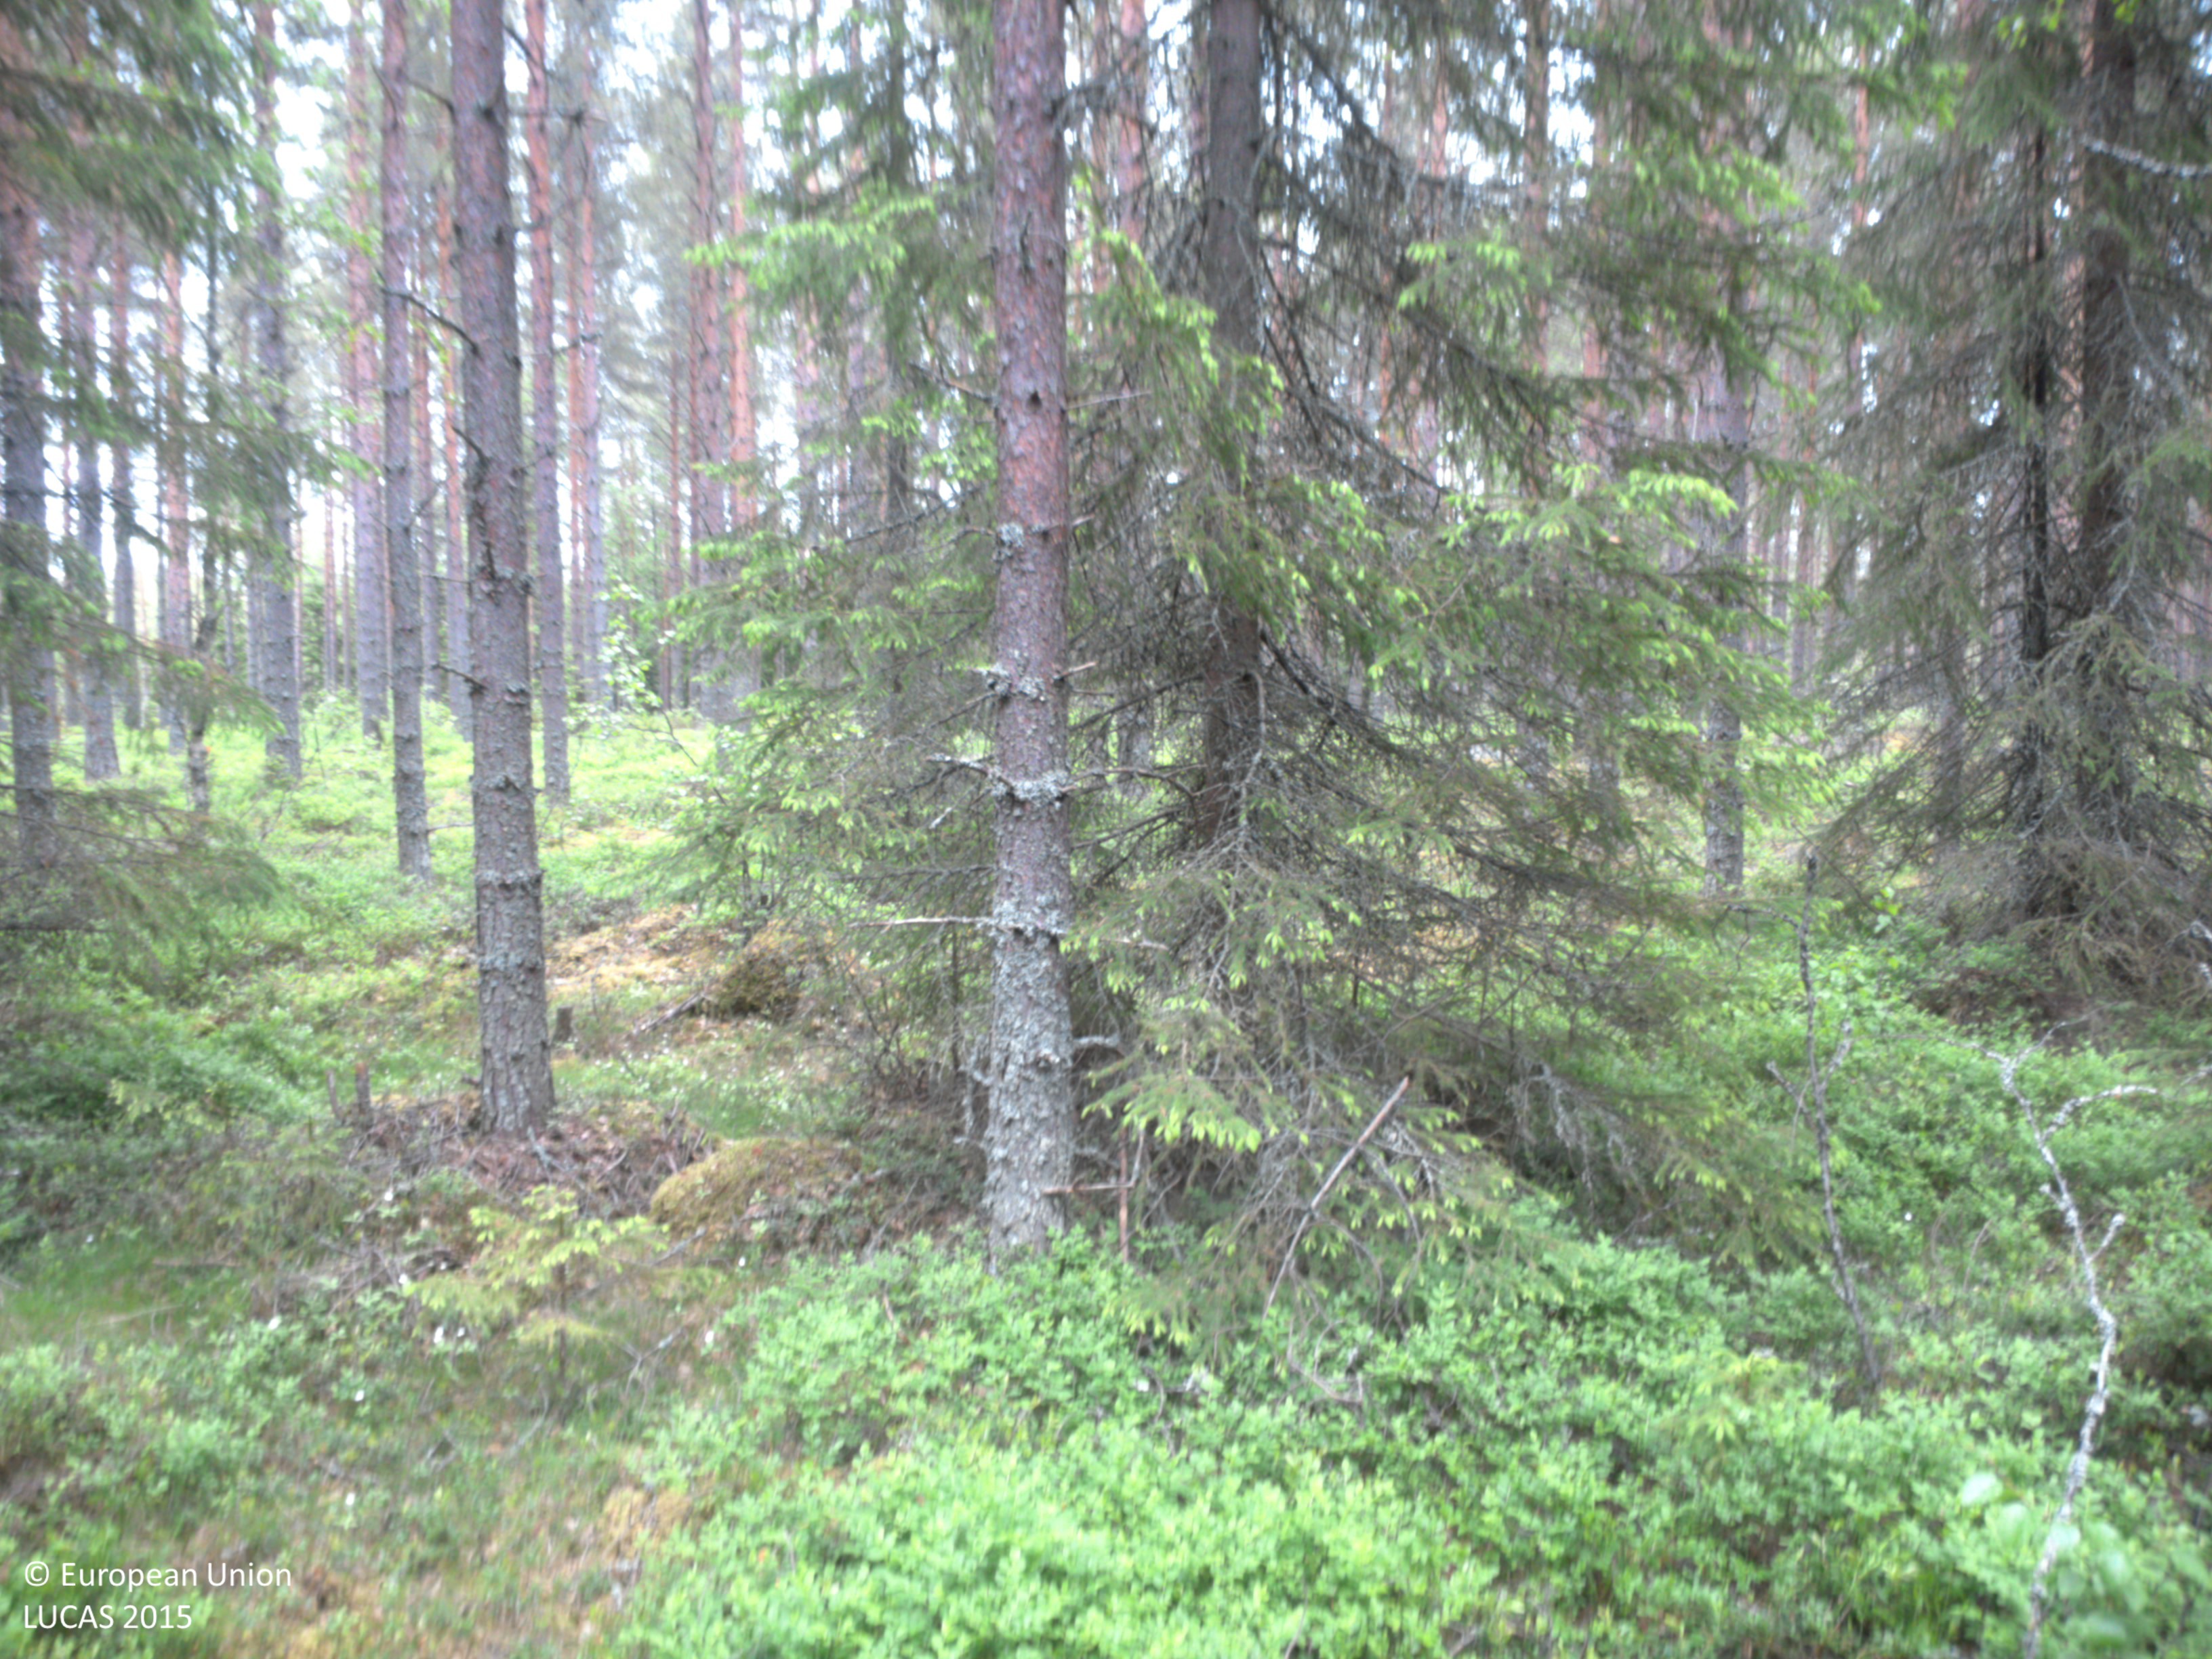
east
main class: Woodland
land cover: Other mixed woodland
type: boreal forest
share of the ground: 50 - 75 %
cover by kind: coniferous forest trees 40 %, broadleaved forest trees 25 %, lichens and mosses 20 %, shrubs 15 %
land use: Forestry
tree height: > 5 m
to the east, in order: Other mixed woodland; Pine dominated coniferous woodland; Tracks; Other mixed woodland; Rivers and streams; Spruce dominated mixed woodland; Broadleaved woodland
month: June
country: SE
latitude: 63.6283
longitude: 19.9699
